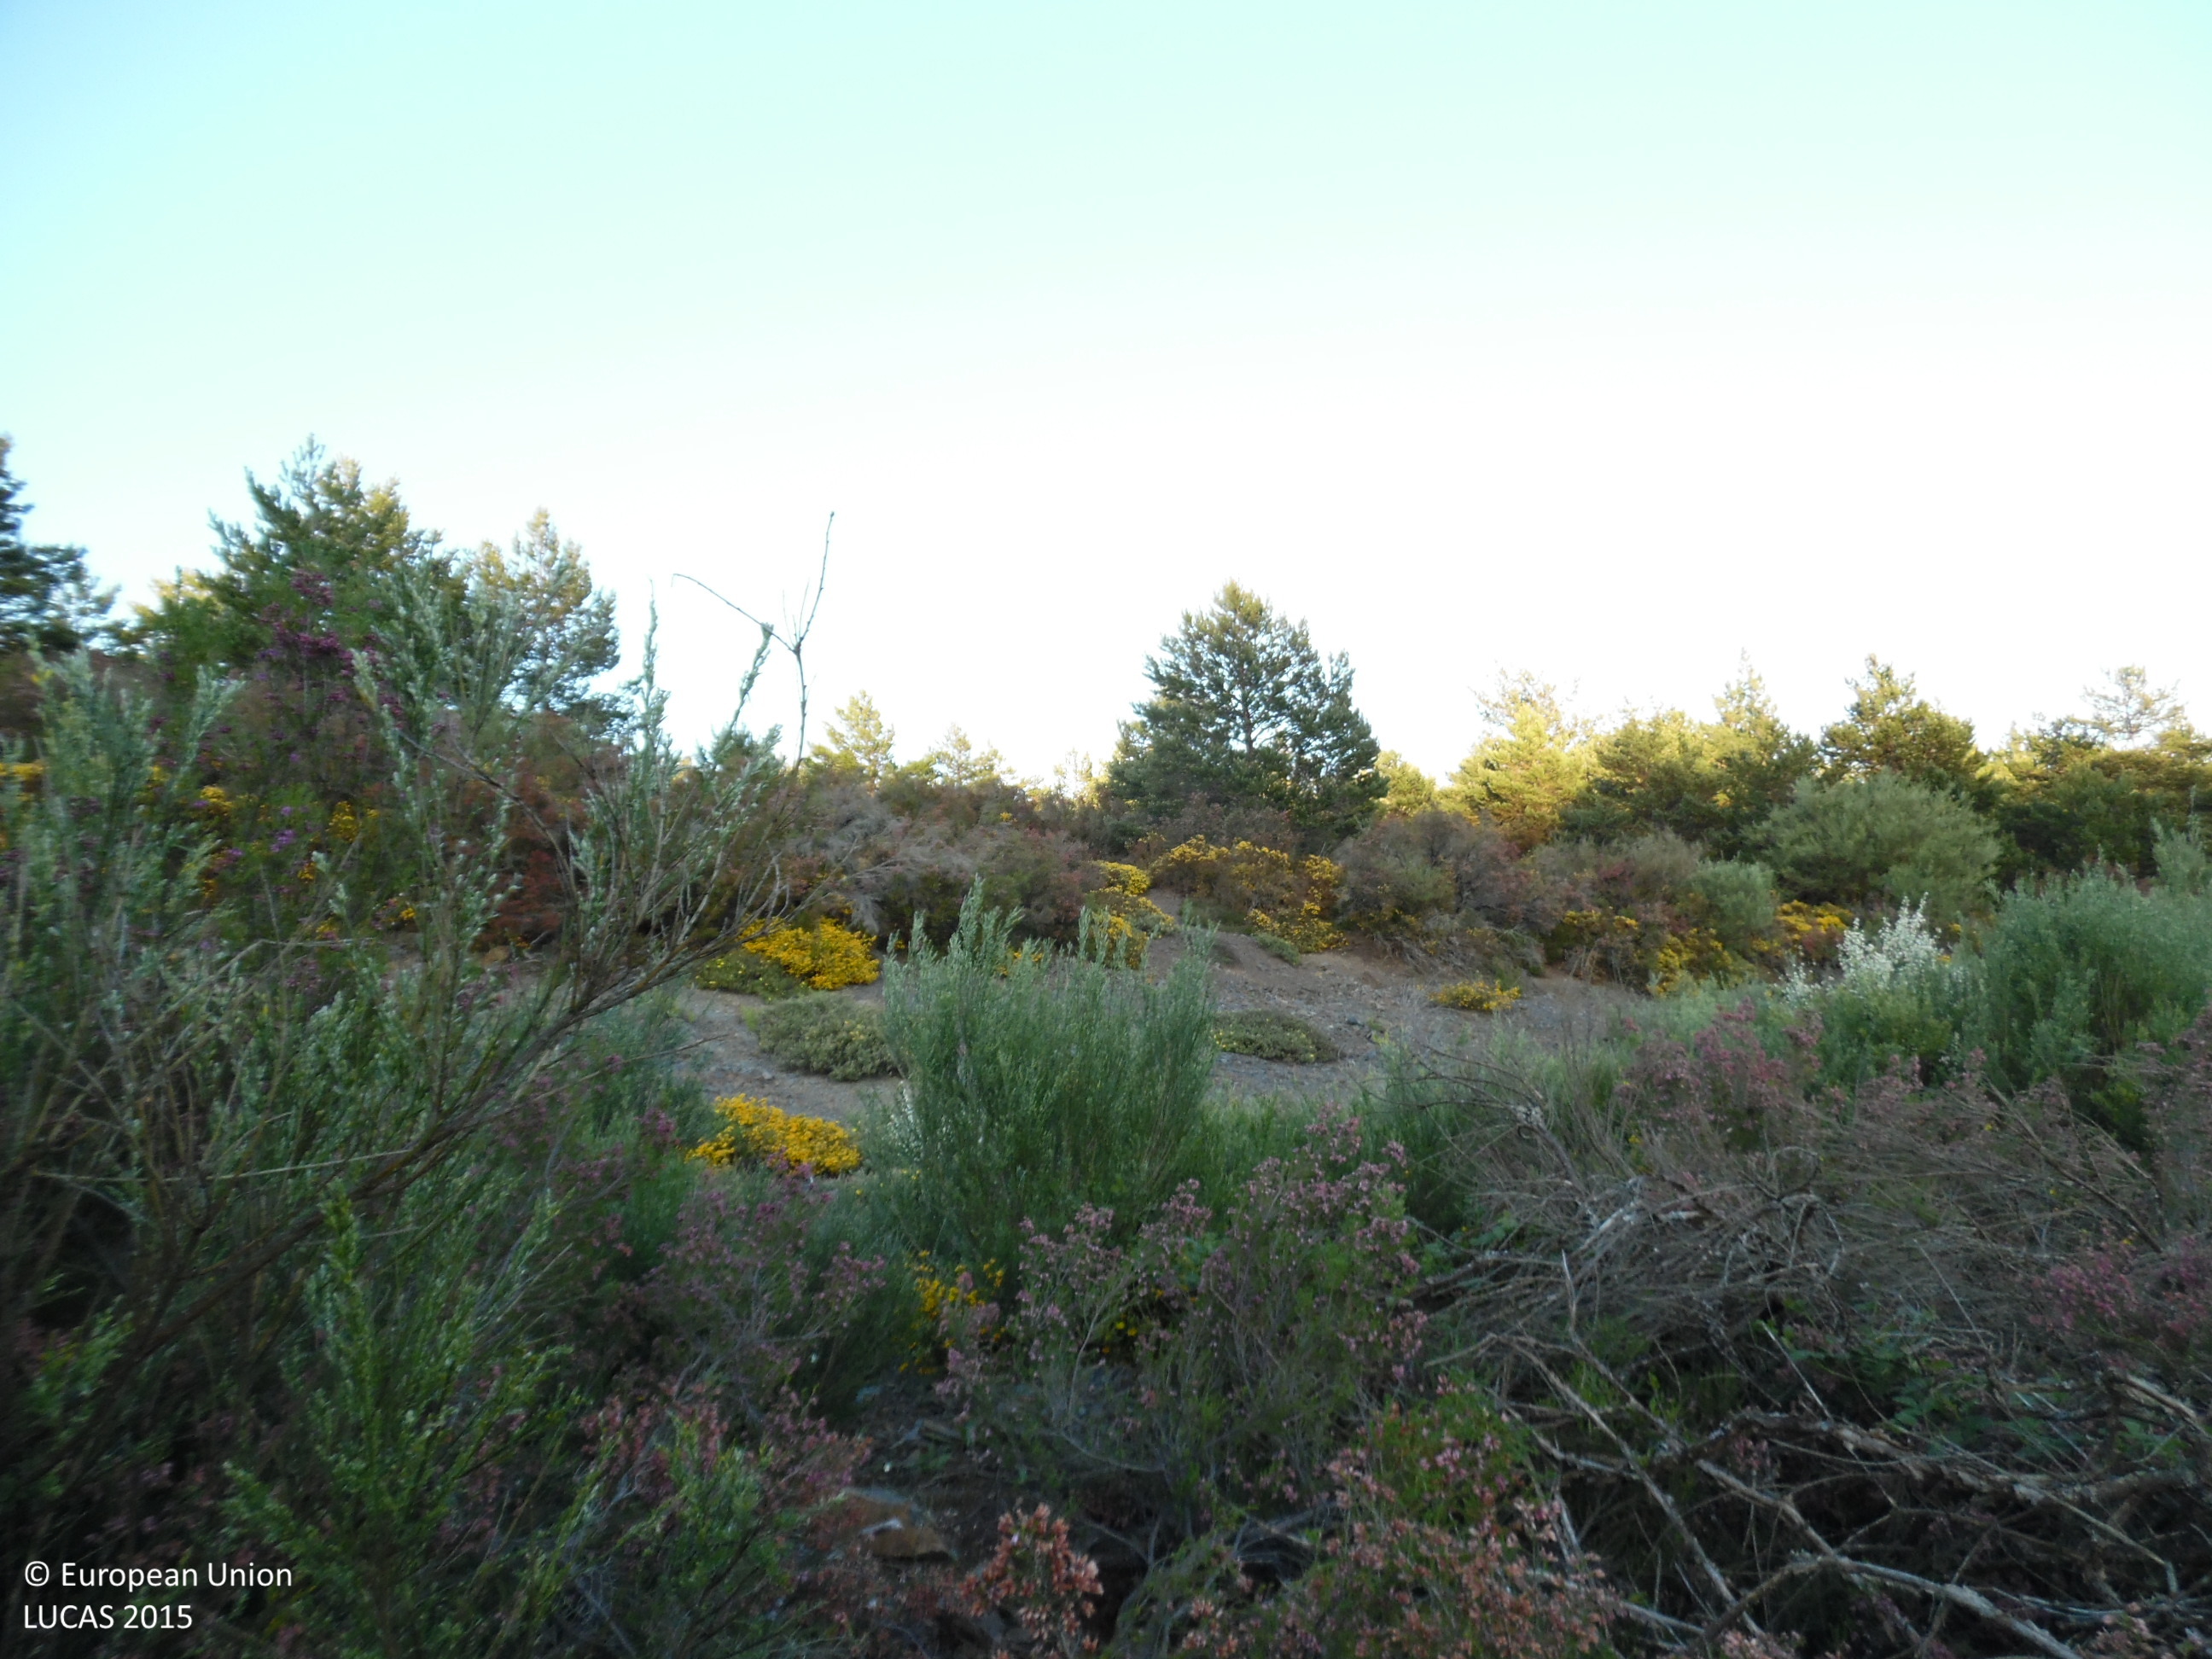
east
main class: Shrubland
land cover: Shrubland without tree cover
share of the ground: 50 - 75 %
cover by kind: shrubs 75 %, consolidated bare surface 25 %
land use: Semi-natural and natural areas not in use
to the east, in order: Shrubland without tree cover; Other structural elements; Rock outcrops; Shrubland with sparse tree cover; Pine dominated coniferous woodland; Shrubland with sparse tree cover; Pine dominated coniferous woodland; Shrubland with sparse tree cover; Pine dominated coniferous woodland; Other bare soil; Pine dominated coniferous woodland; Other structural elements
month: May
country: ES
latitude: 42.6565
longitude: -6.1273
